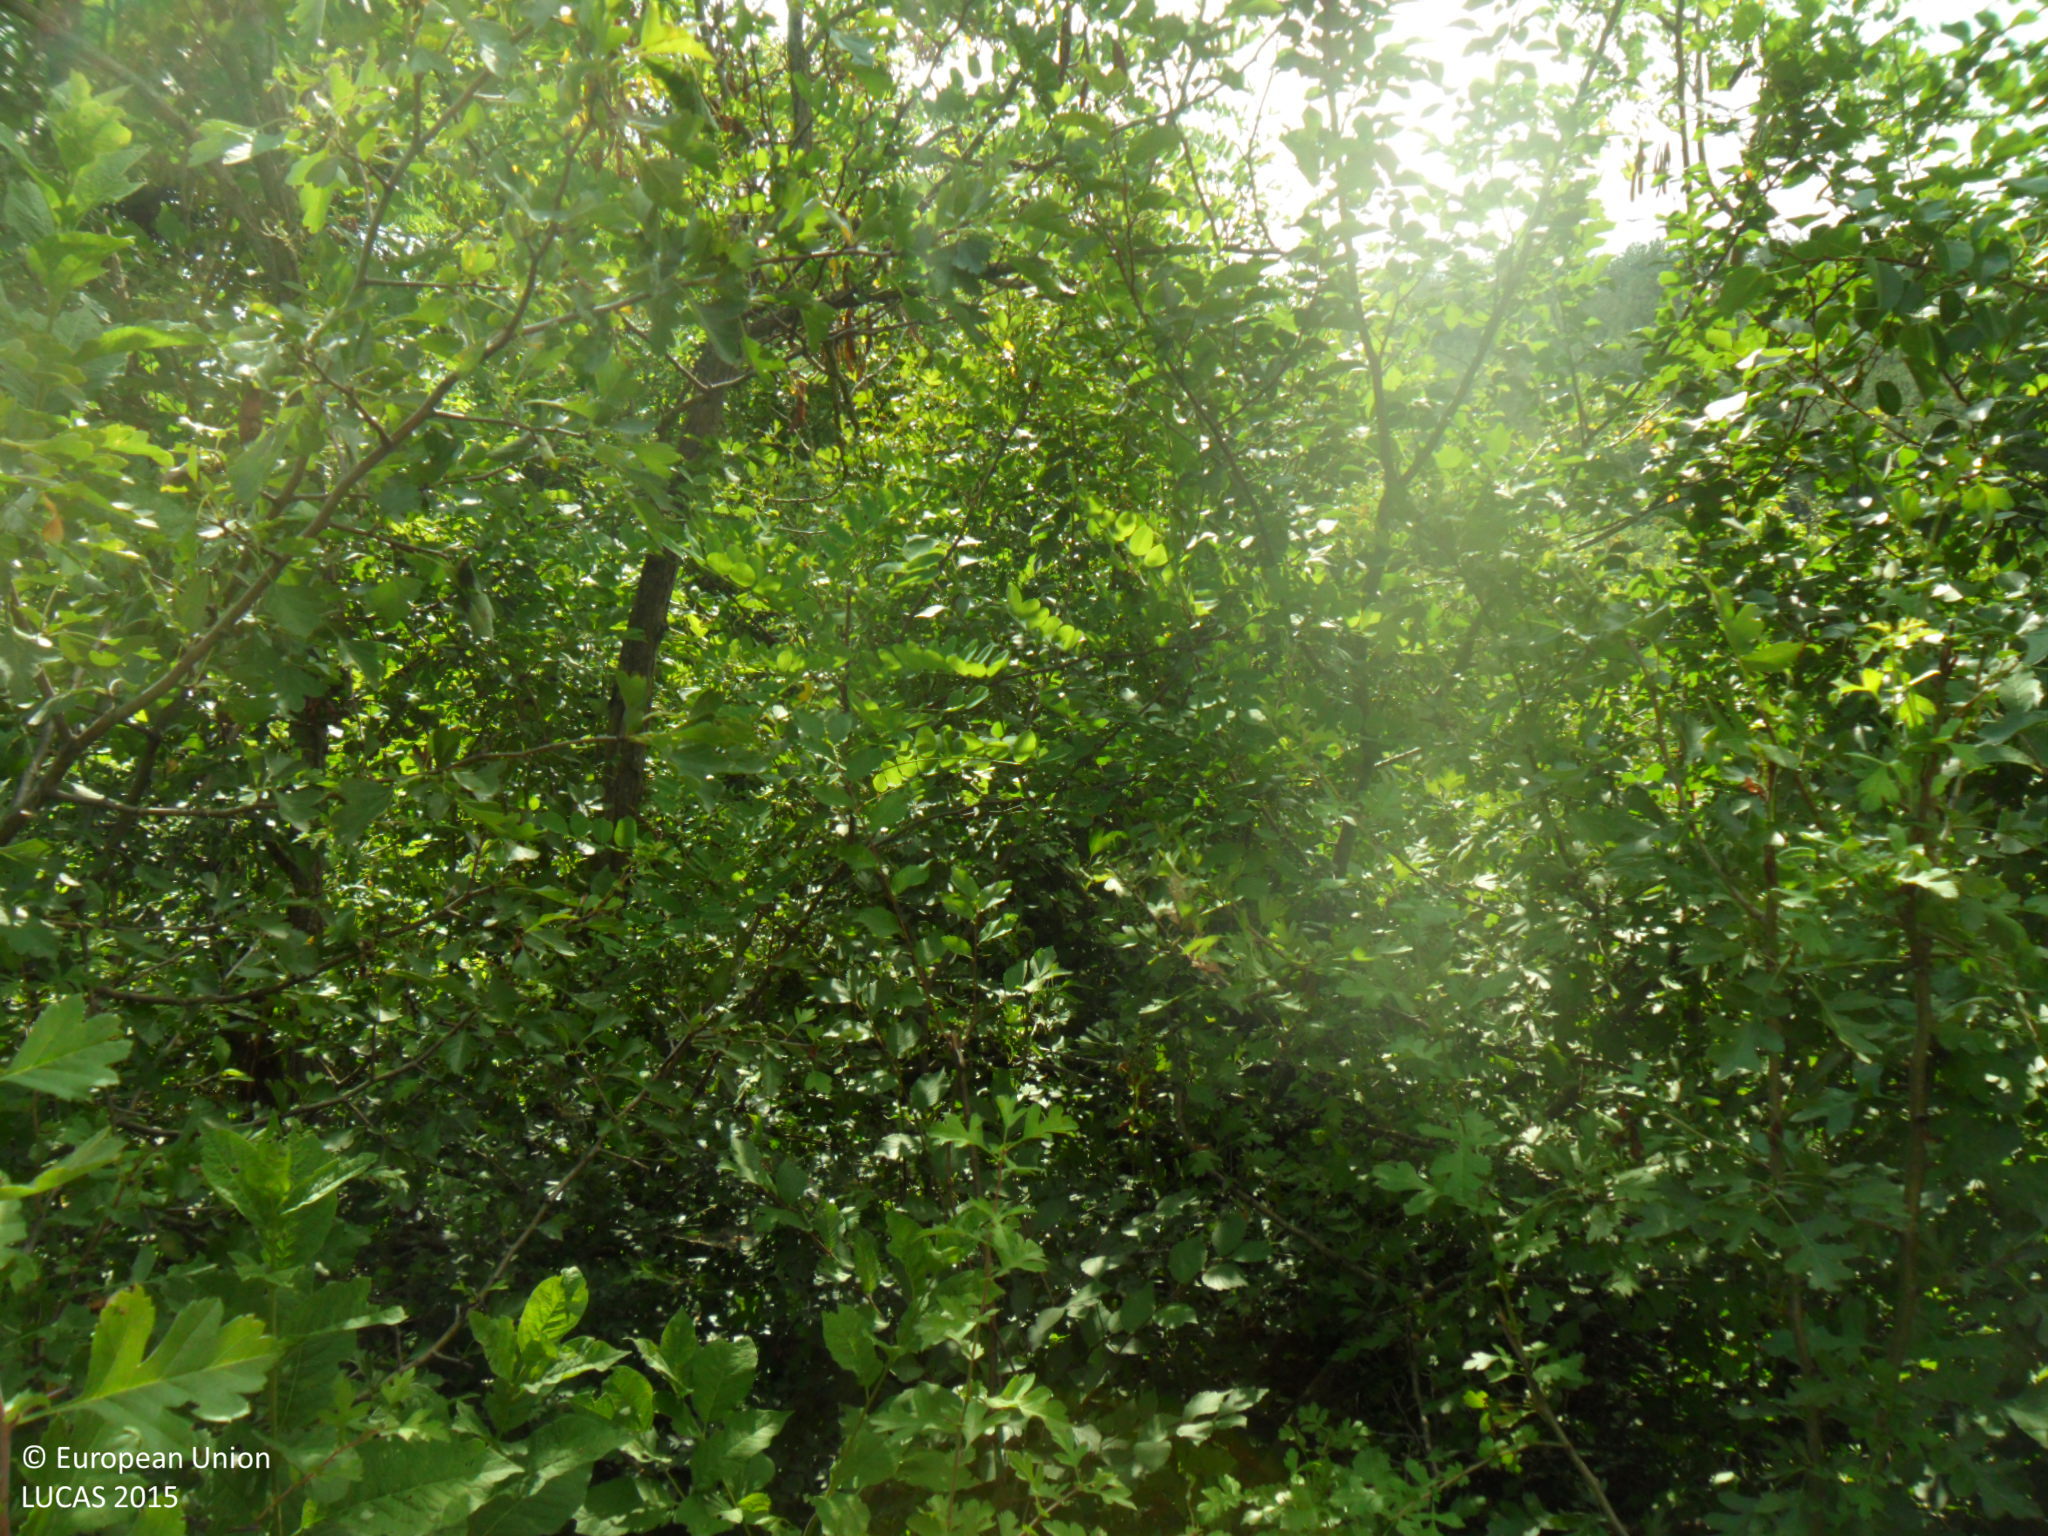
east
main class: Shrubland
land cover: Shrubland with sparse tree cover
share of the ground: > 75 %
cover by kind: shrubs 90 %, broadleaved forest trees 5 %, herbaceous plants 5 %
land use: Semi-natural and natural areas not in use
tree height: < 5 m
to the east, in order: Shrubland with sparse tree cover; Ditches and canals; Shrubland with sparse tree cover; Grassland without tree/shrub cover; Abandoned hedges; Grassland without tree/shrub cover; Tracks; Broadleaved woodland; Pine dominated coniferous woodland
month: July
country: BG
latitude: 43.3812
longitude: 27.1919
